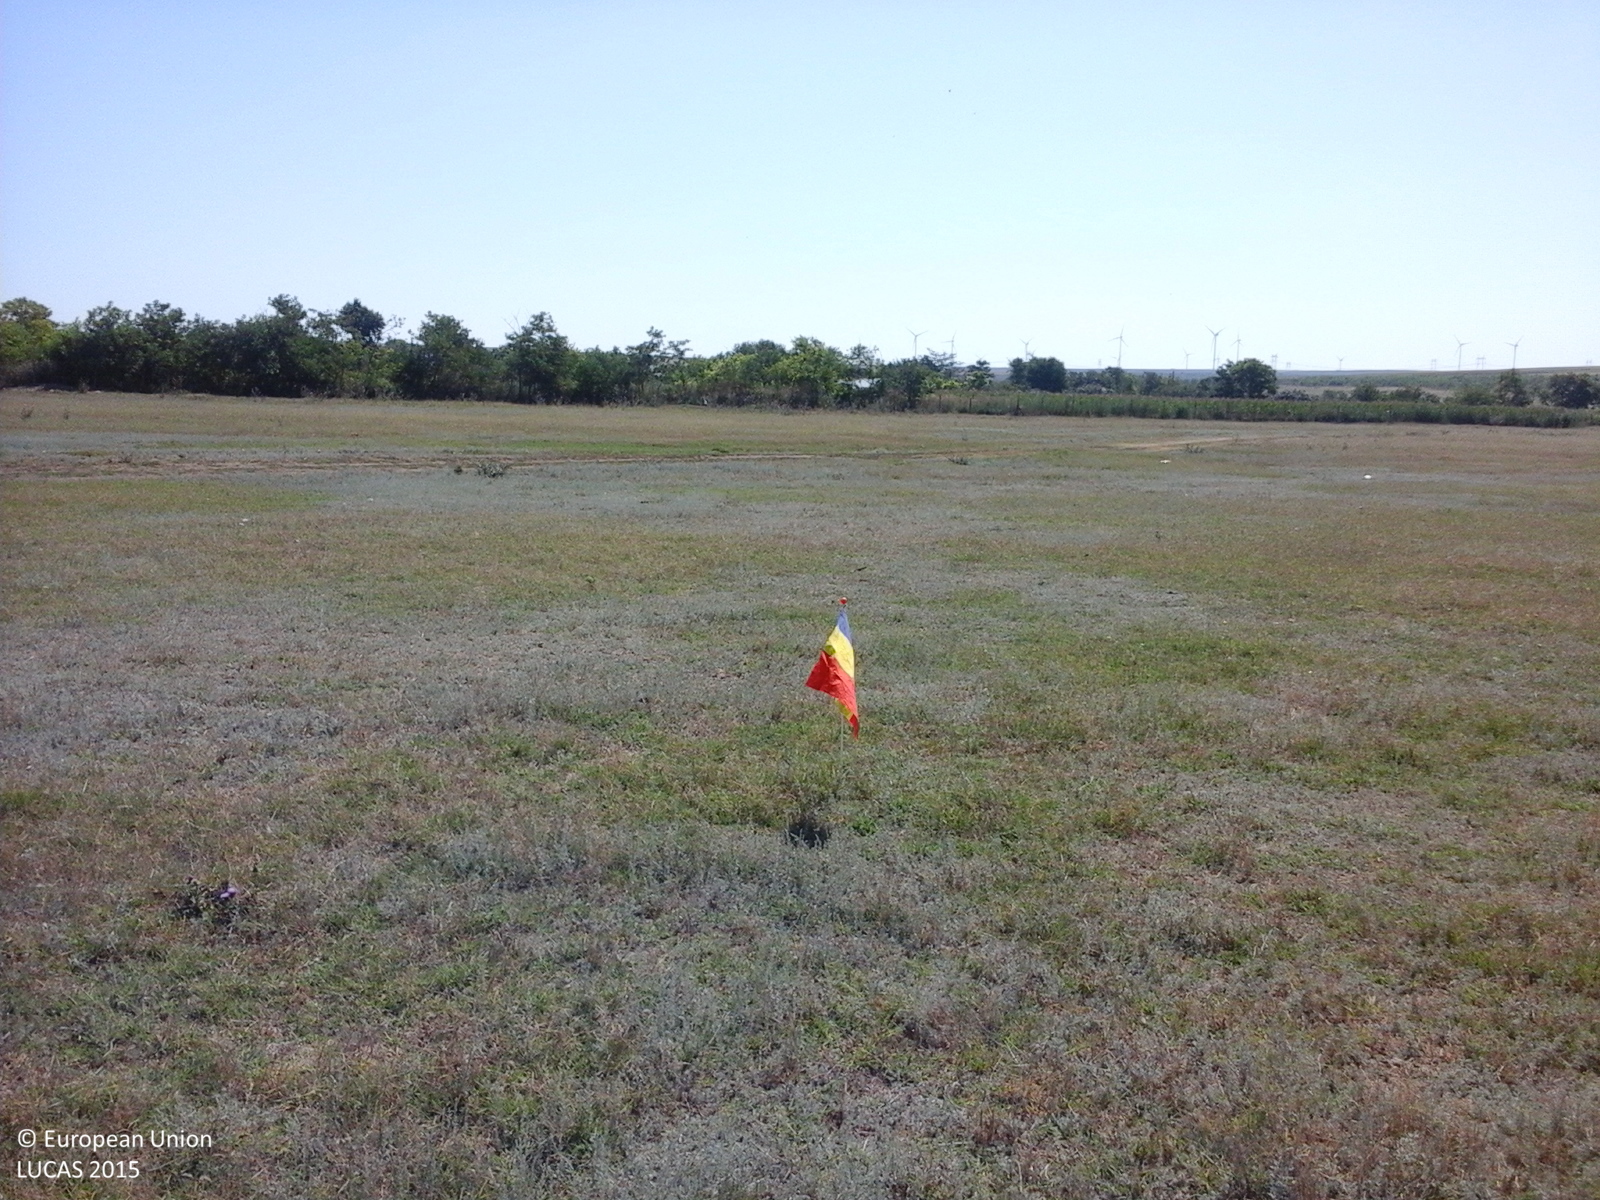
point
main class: Grassland
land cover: Grassland without tree/shrub cover
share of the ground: > 75 %
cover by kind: herbaceous plants 100 %
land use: Agriculture (excluding fallow land and kitchen gardens)
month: August
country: RO
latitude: 44.6290
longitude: 28.1772
